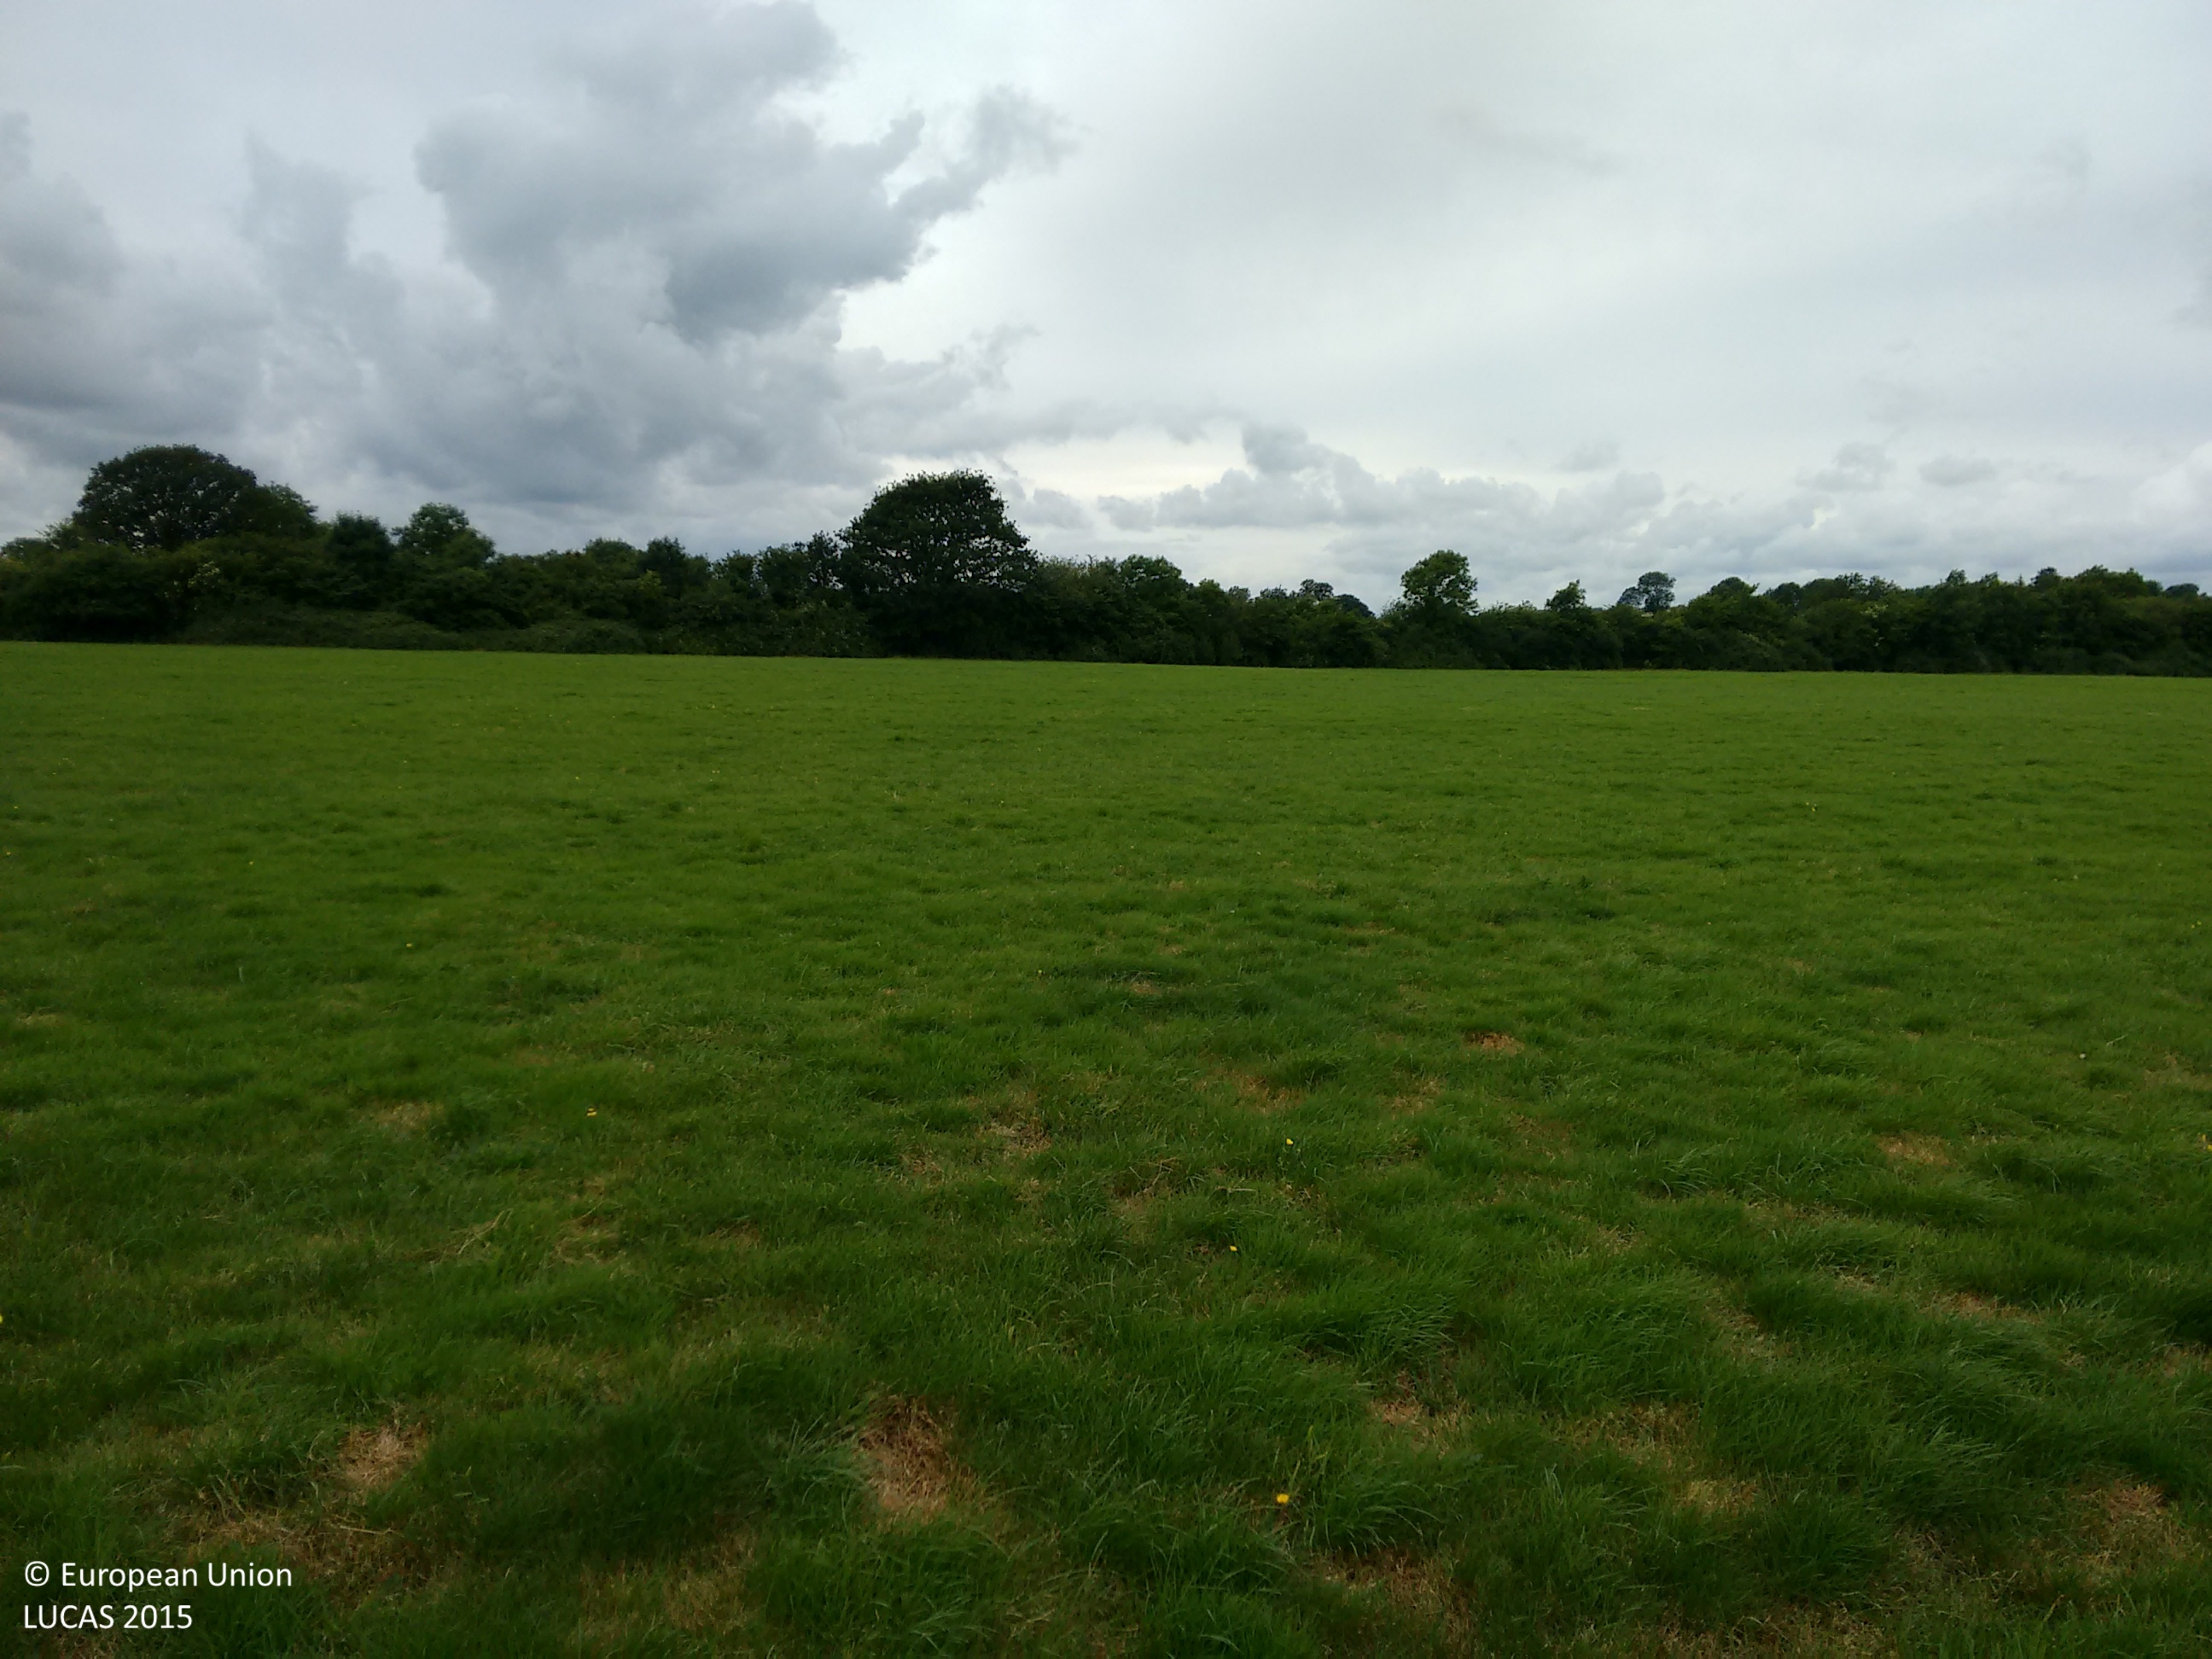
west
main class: Grassland
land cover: Grassland without tree/shrub cover
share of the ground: > 75 %
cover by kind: herbaceous plants 100 %
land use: Agriculture (excluding fallow land and kitchen gardens)
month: July
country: IE
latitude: 52.5564
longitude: -7.4895
